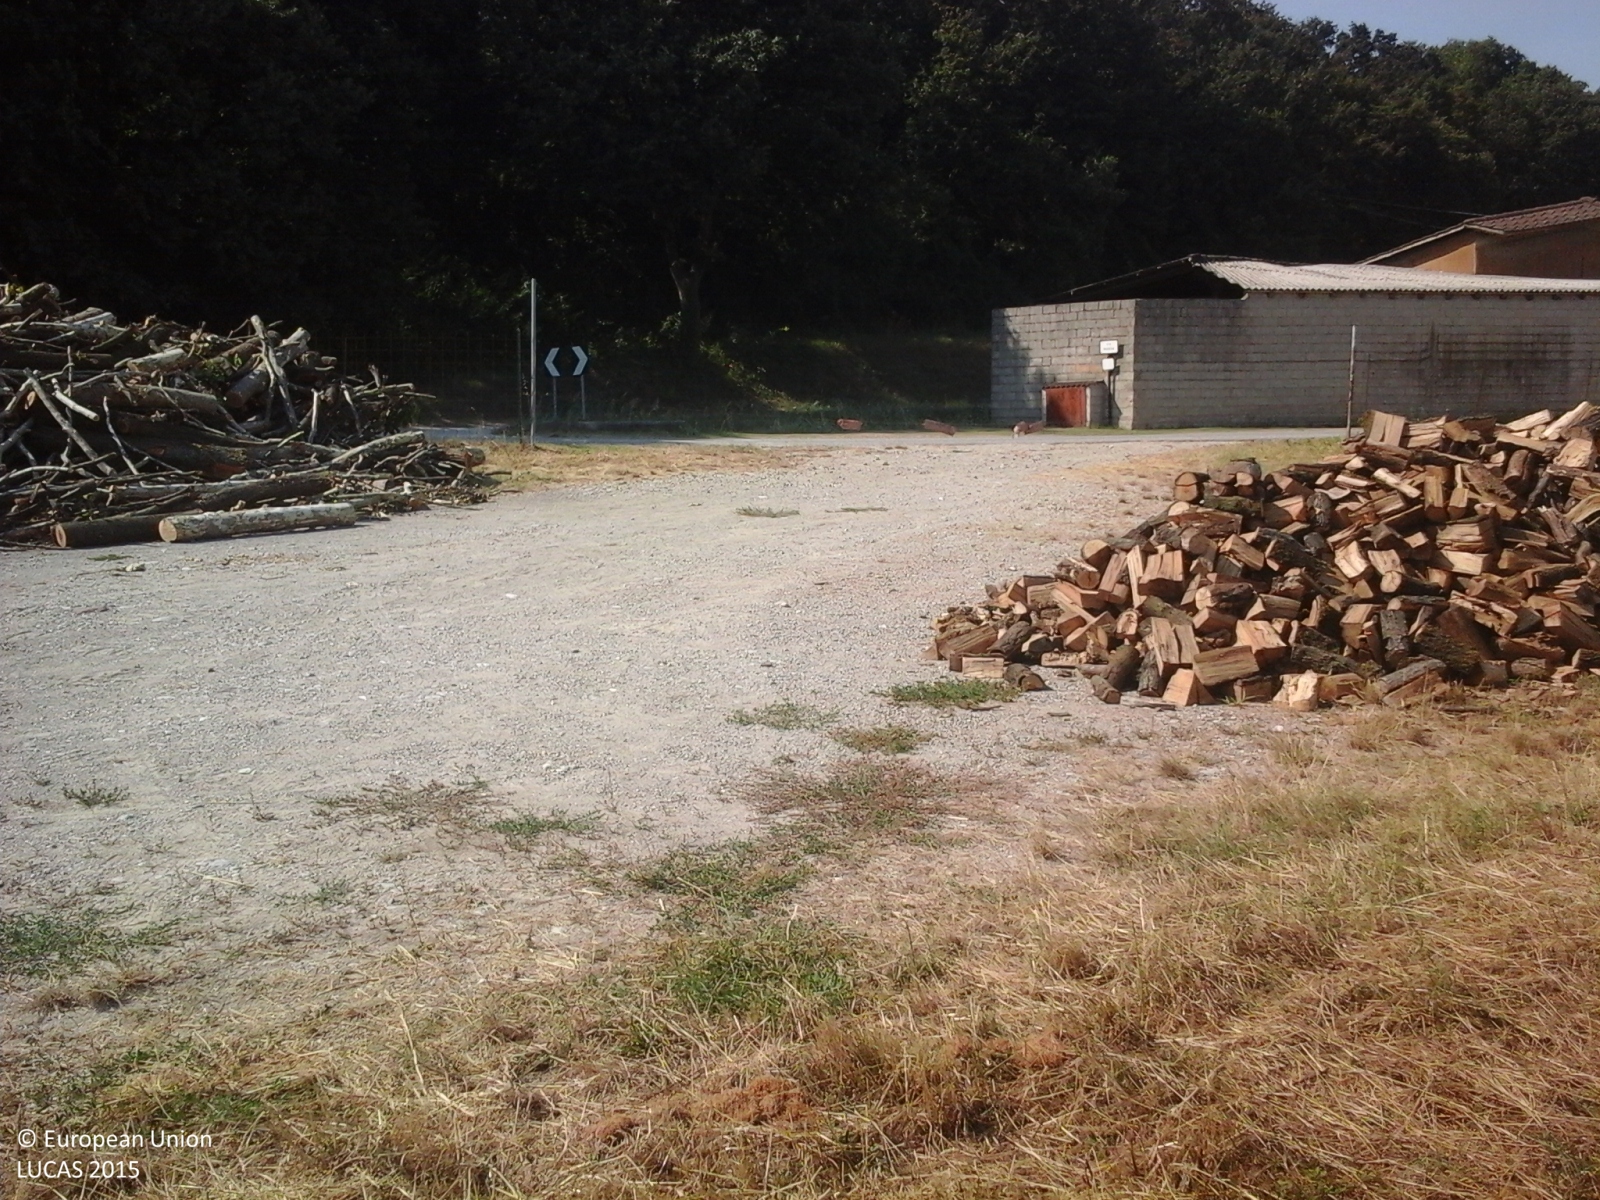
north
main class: Grassland
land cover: Grassland without tree/shrub cover
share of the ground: > 75 %
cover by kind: herbaceous plants 100 %
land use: Agriculture (excluding fallow land and kitchen gardens)
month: July
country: IT
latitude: 45.4311
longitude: 10.4976
